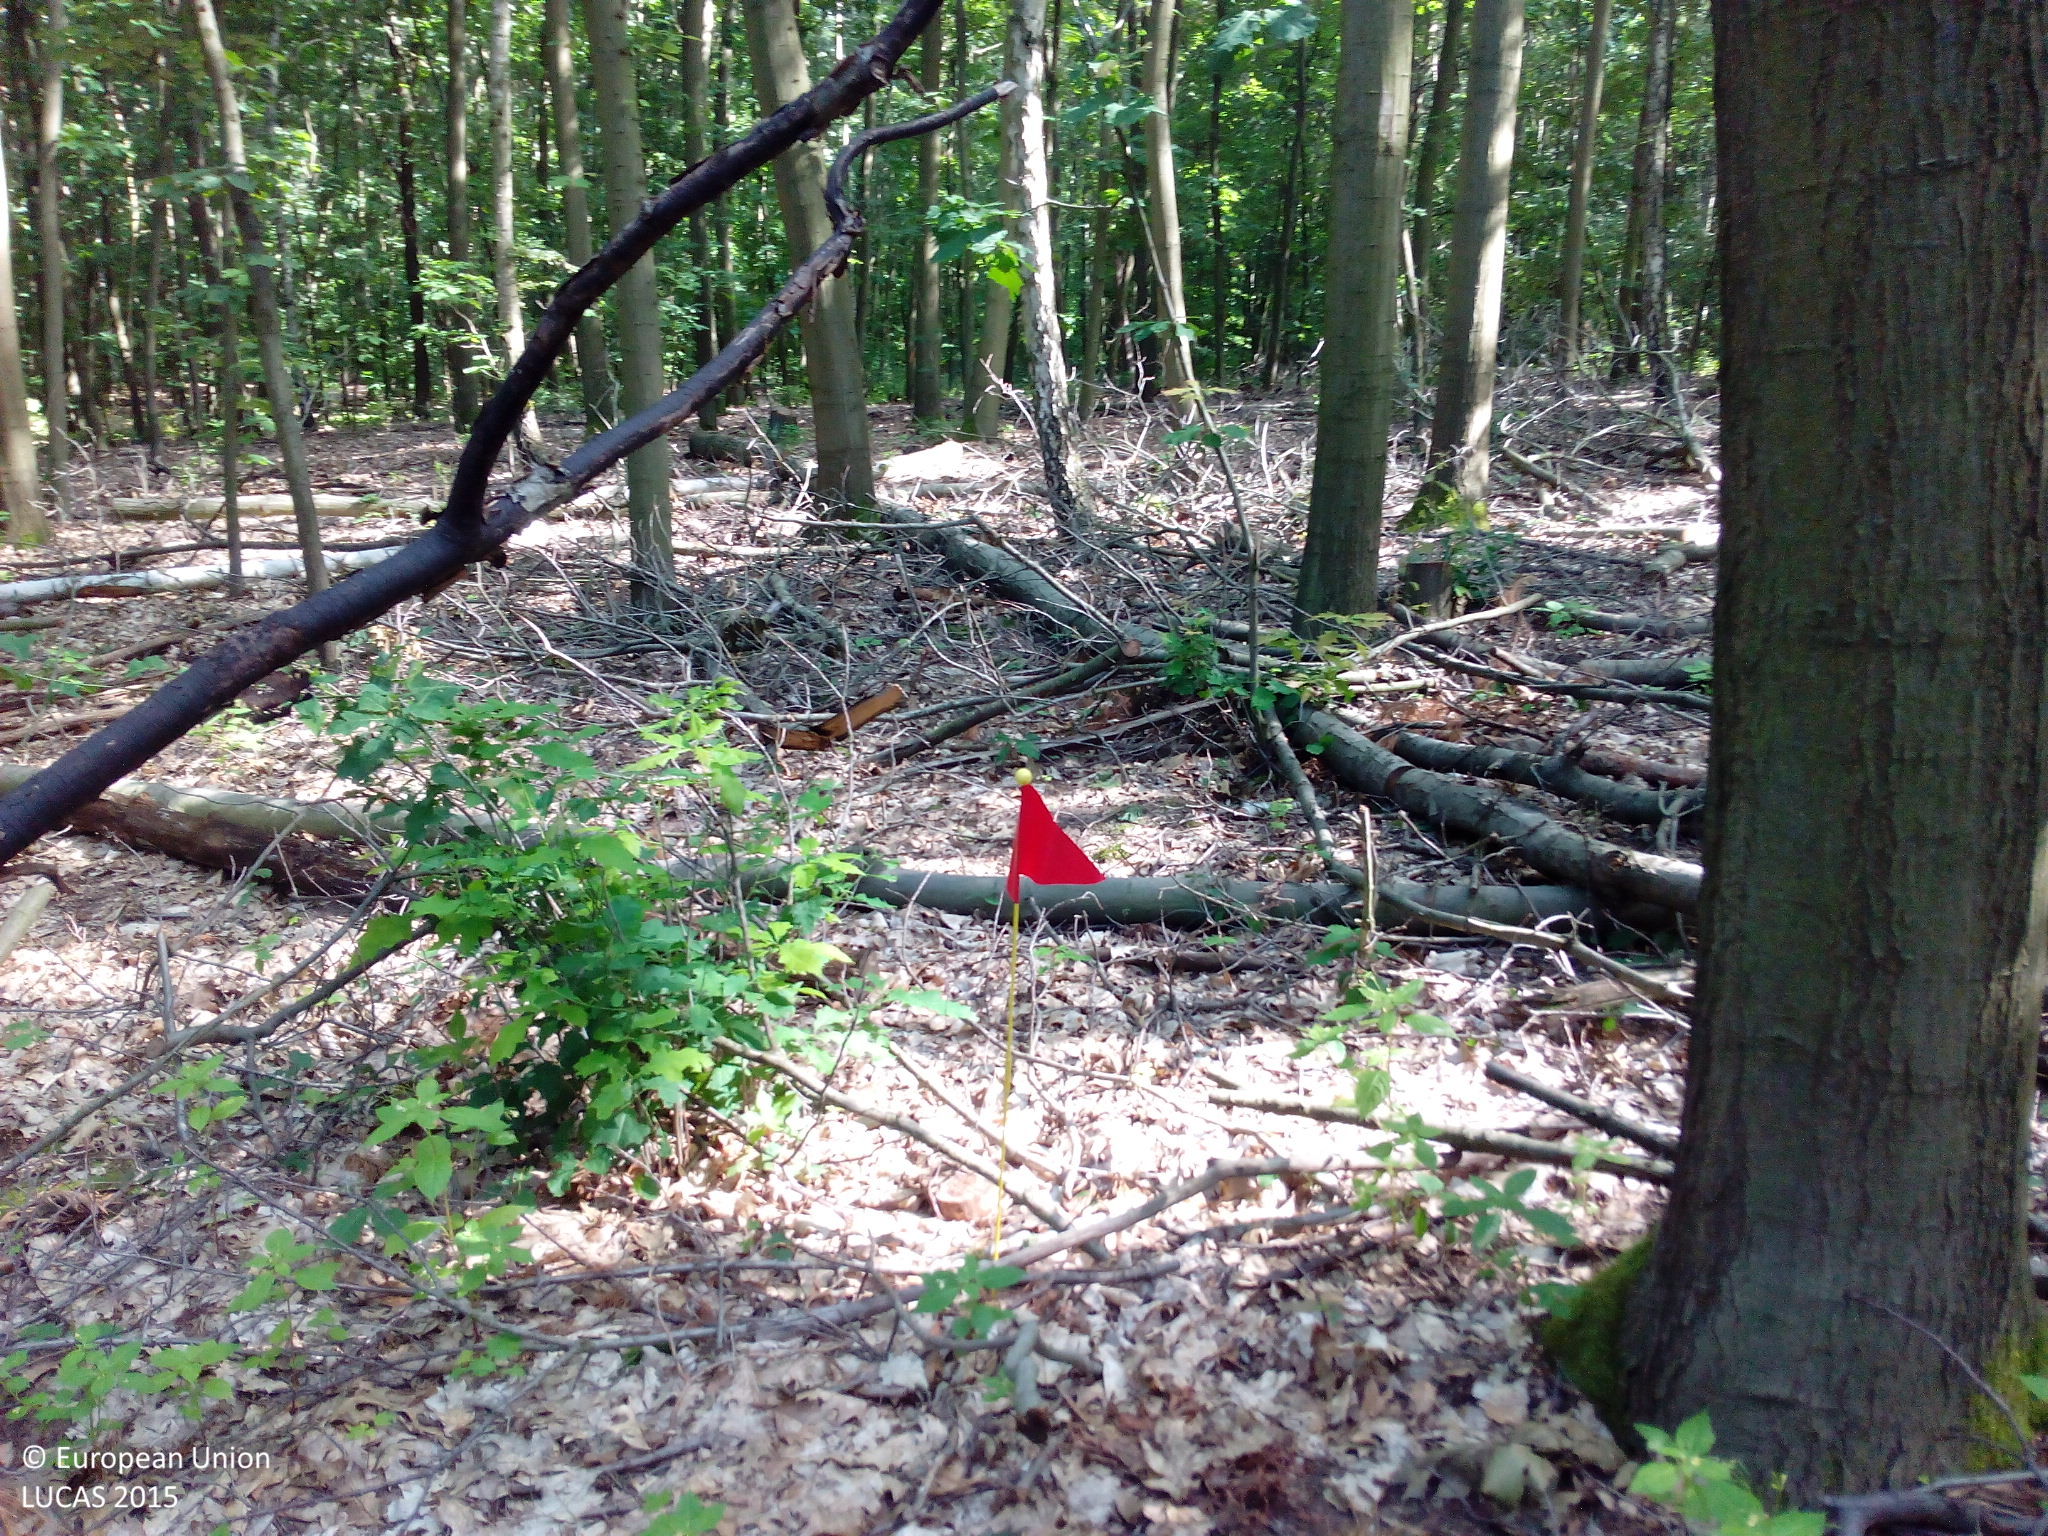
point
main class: Woodland
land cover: Broadleaved woodland
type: mesophytic deciduous forest
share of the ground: > 75 %
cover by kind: broadleaved forest trees 80 %, unconsolidated bare surface 20 %
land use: Forestry
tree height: > 5 m
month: July
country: DE
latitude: 52.4792
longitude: 13.1655
